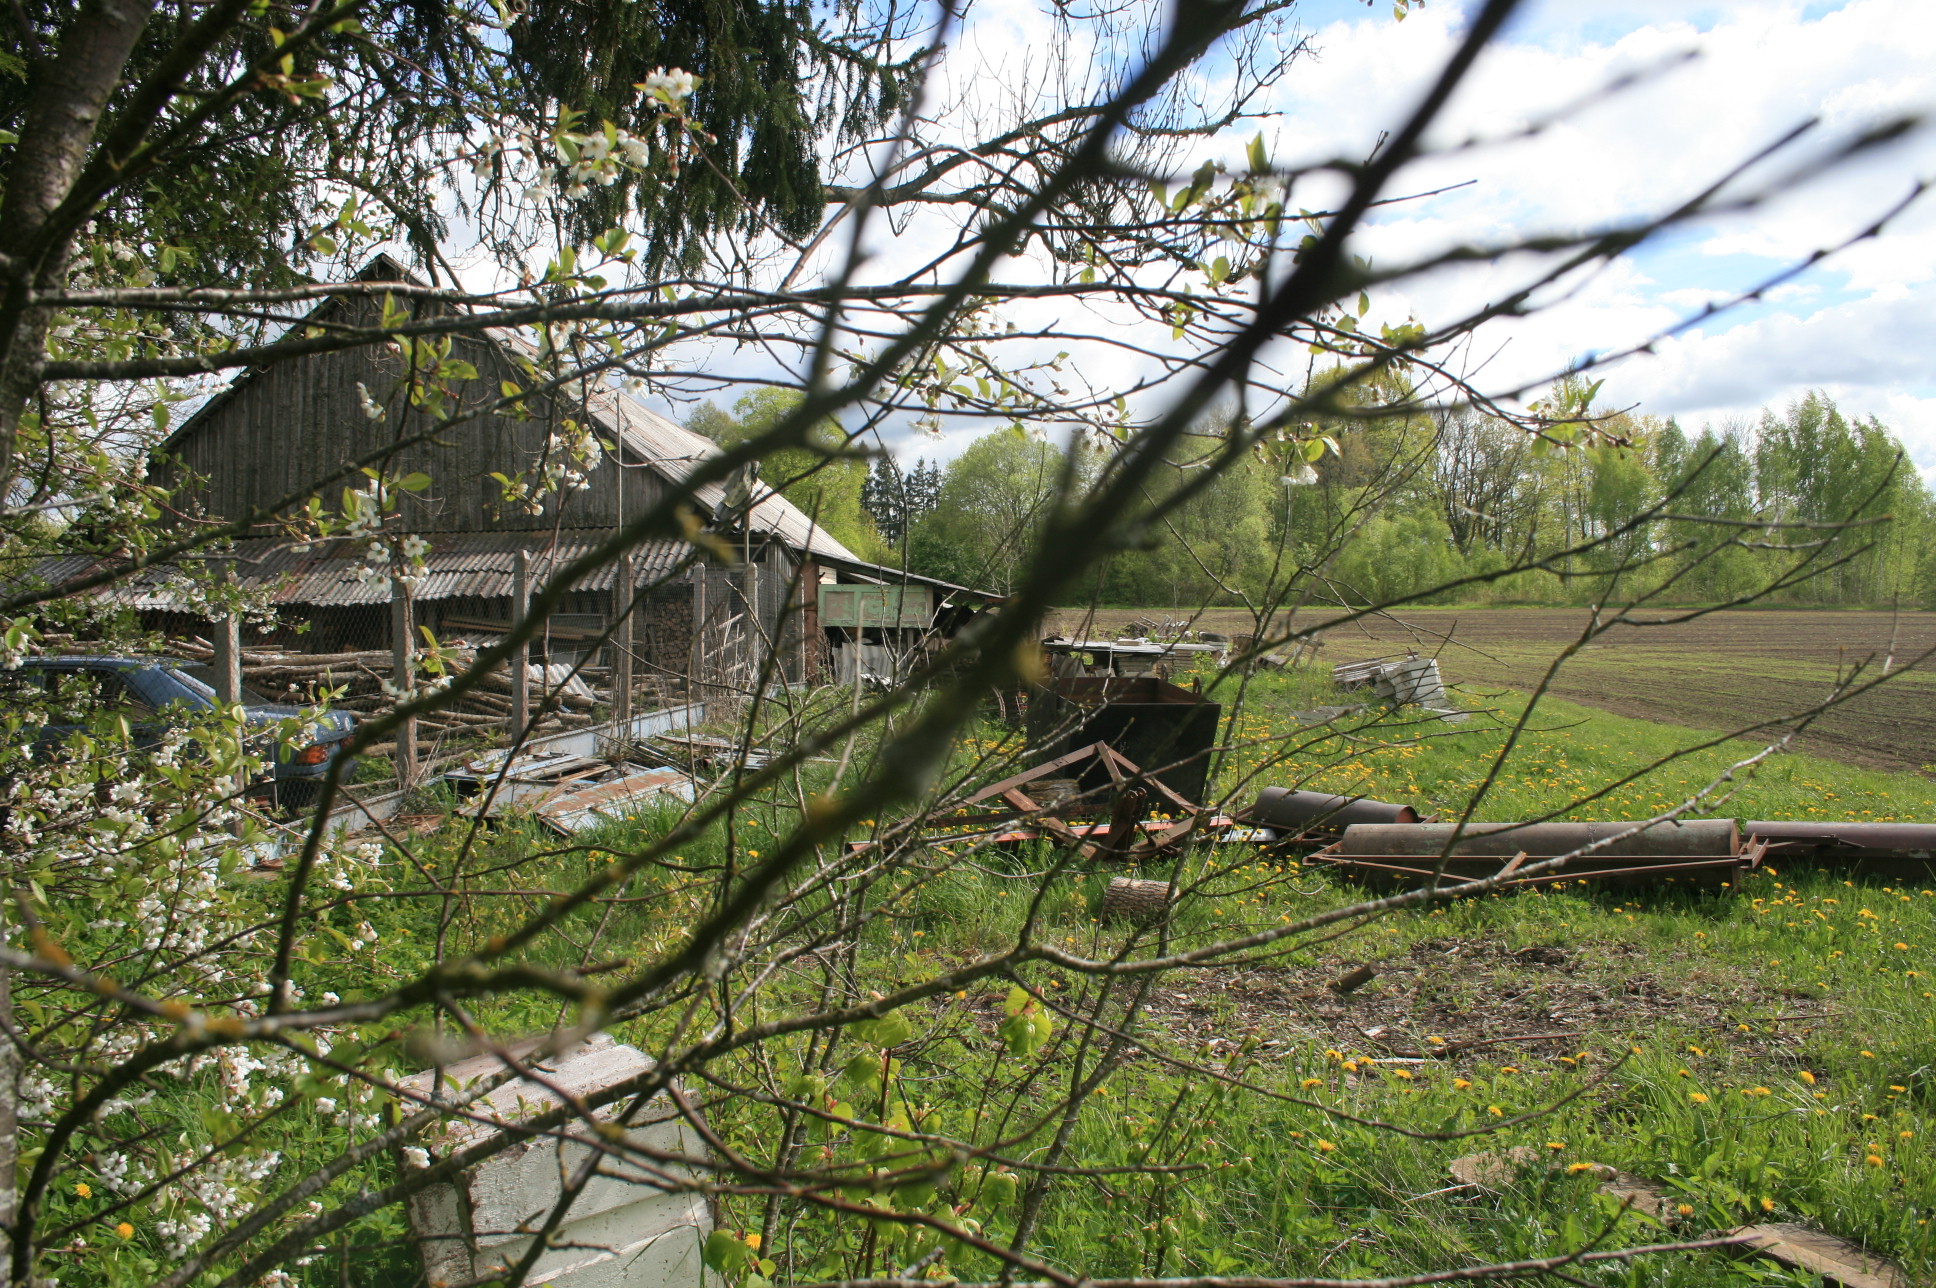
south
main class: Woodland
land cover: Spruce dominated mixed woodland
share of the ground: > 75 %
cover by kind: coniferous forest trees 55 %, broadleaved forest trees 45 %
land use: Residential
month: May
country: LT
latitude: 56.2167
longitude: 22.0648
